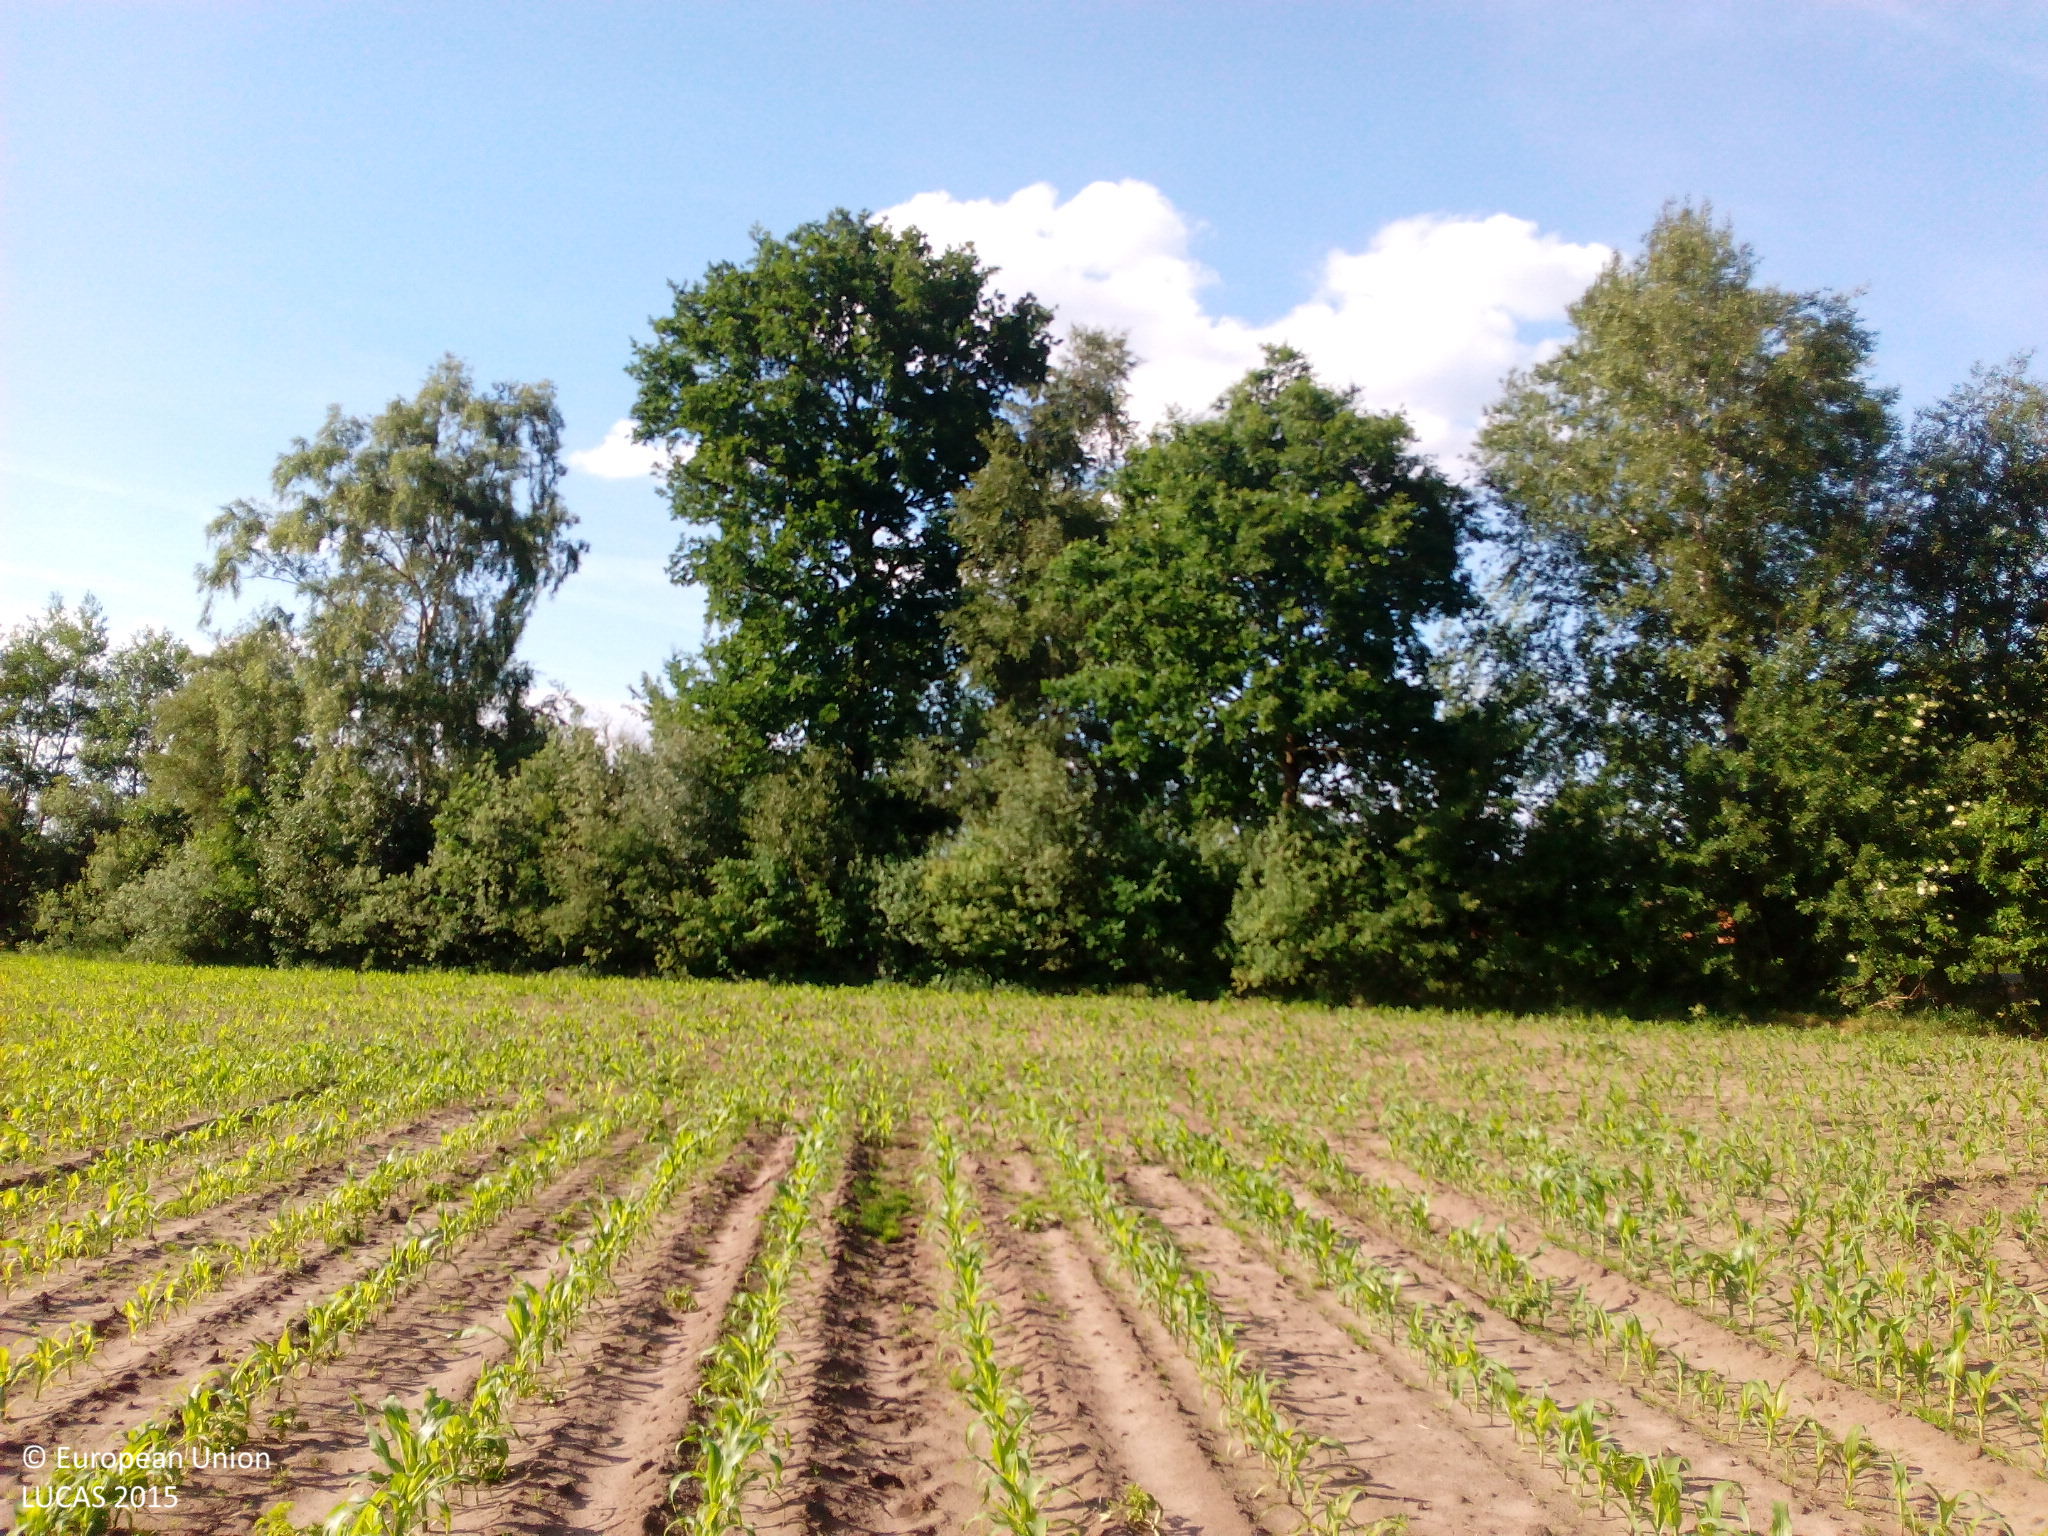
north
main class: Cropland
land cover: Maize
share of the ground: 10 - 25 %
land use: Agriculture (excluding fallow land and kitchen gardens)
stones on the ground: < 10 %
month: June
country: DE
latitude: 52.4754
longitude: 7.4239
